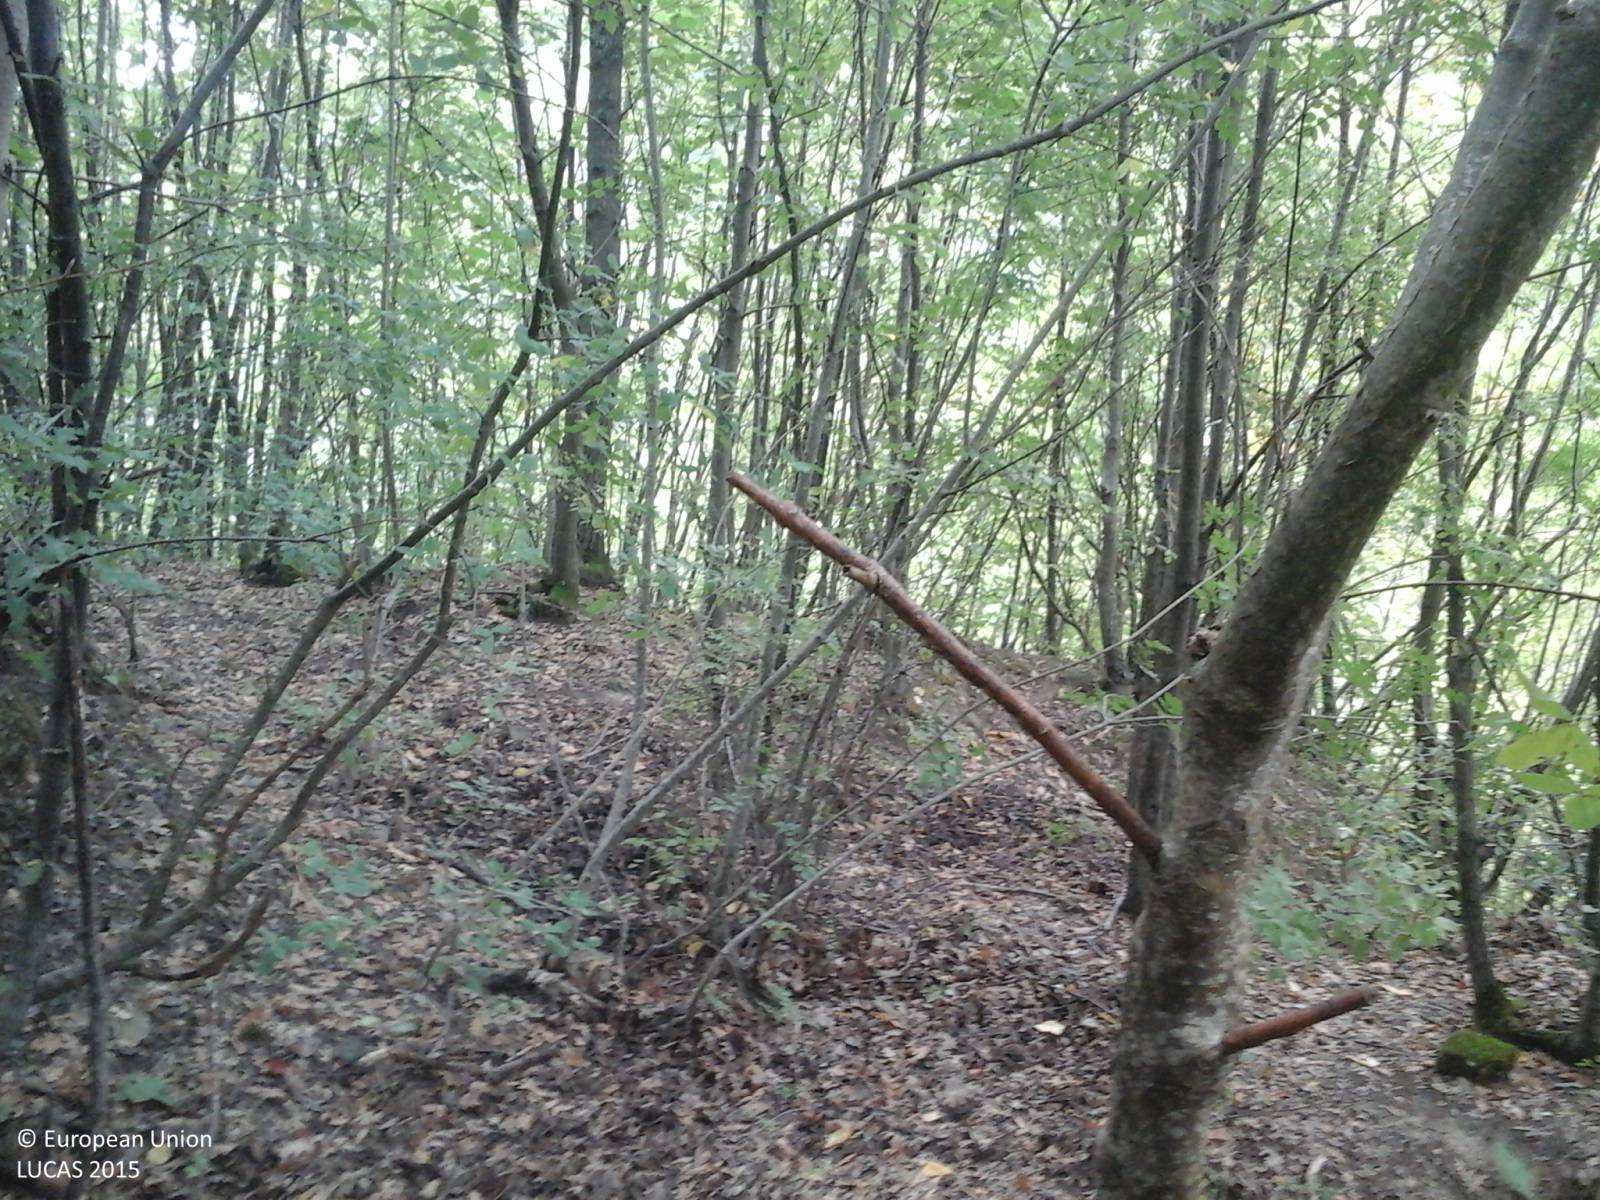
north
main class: Woodland
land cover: Broadleaved woodland
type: thermophilous deciduous forest
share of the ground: > 75 %
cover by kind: broadleaved forest trees 100 %
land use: Forestry
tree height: > 5 m
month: October
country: IT
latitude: 42.7268
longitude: 13.2998
